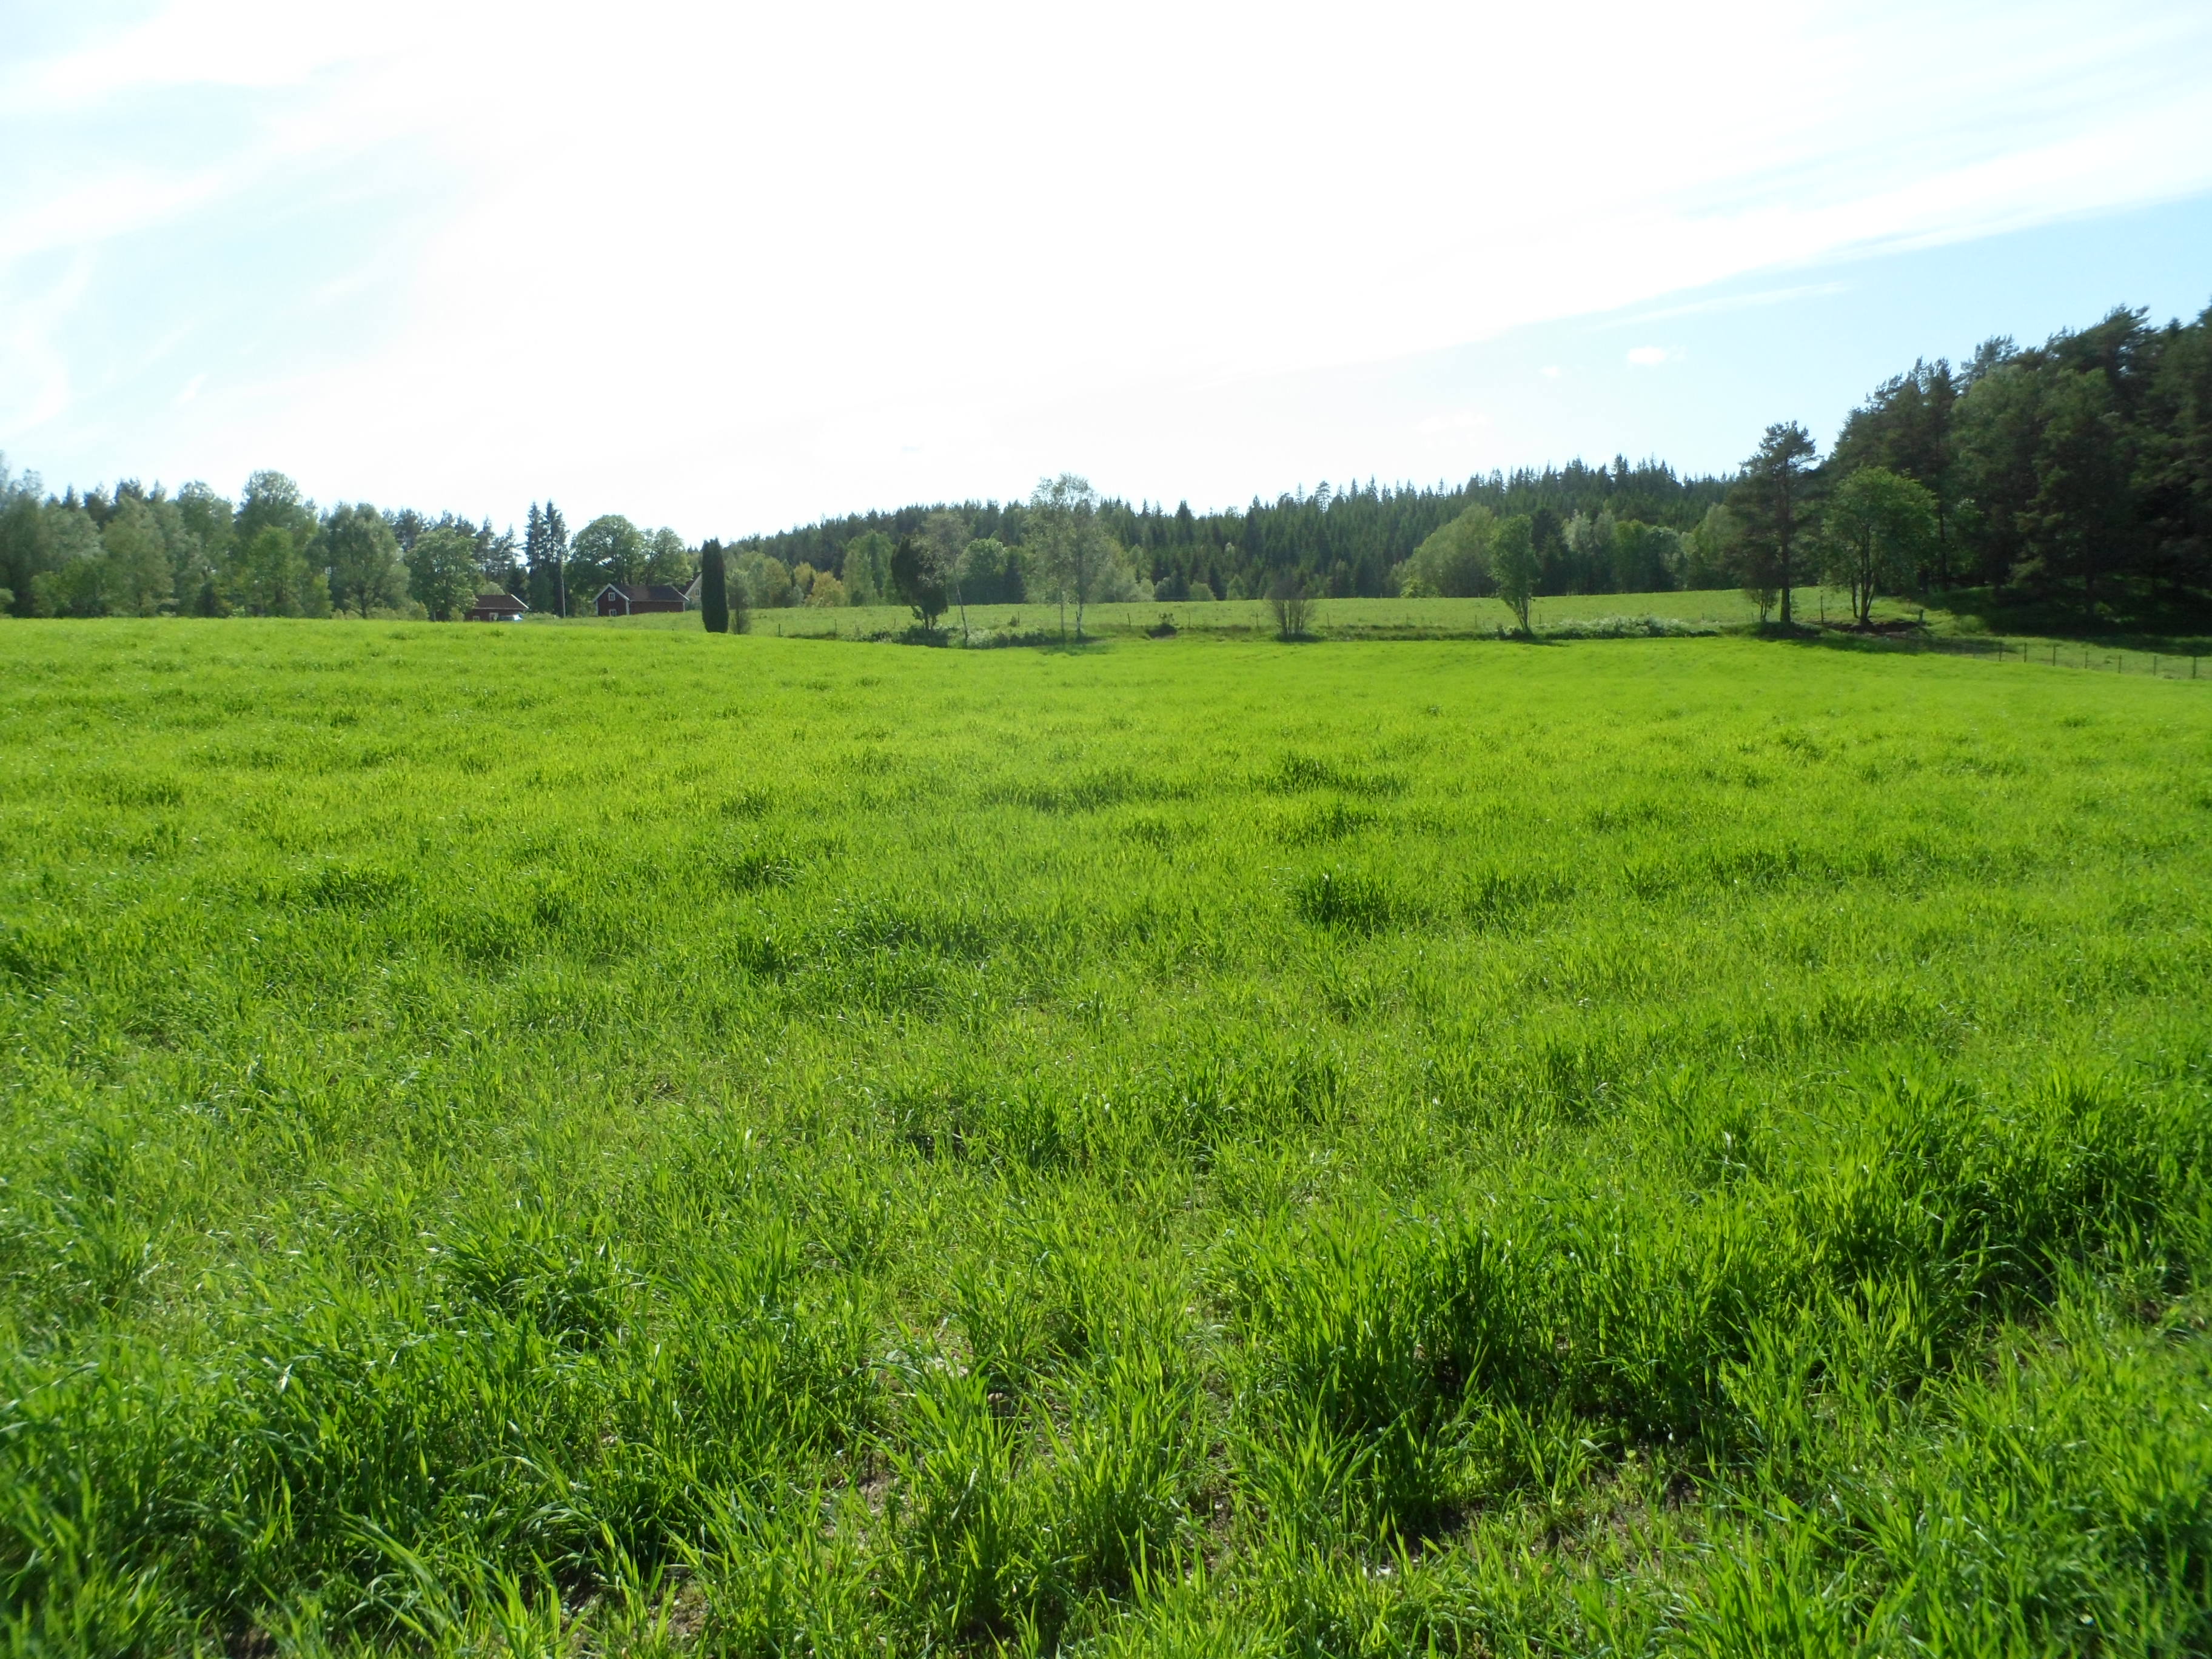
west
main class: Cropland
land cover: Barley
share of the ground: > 75 %
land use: Agriculture (excluding fallow land and kitchen gardens)
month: June
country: SE
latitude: 57.4659
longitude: 14.3136
